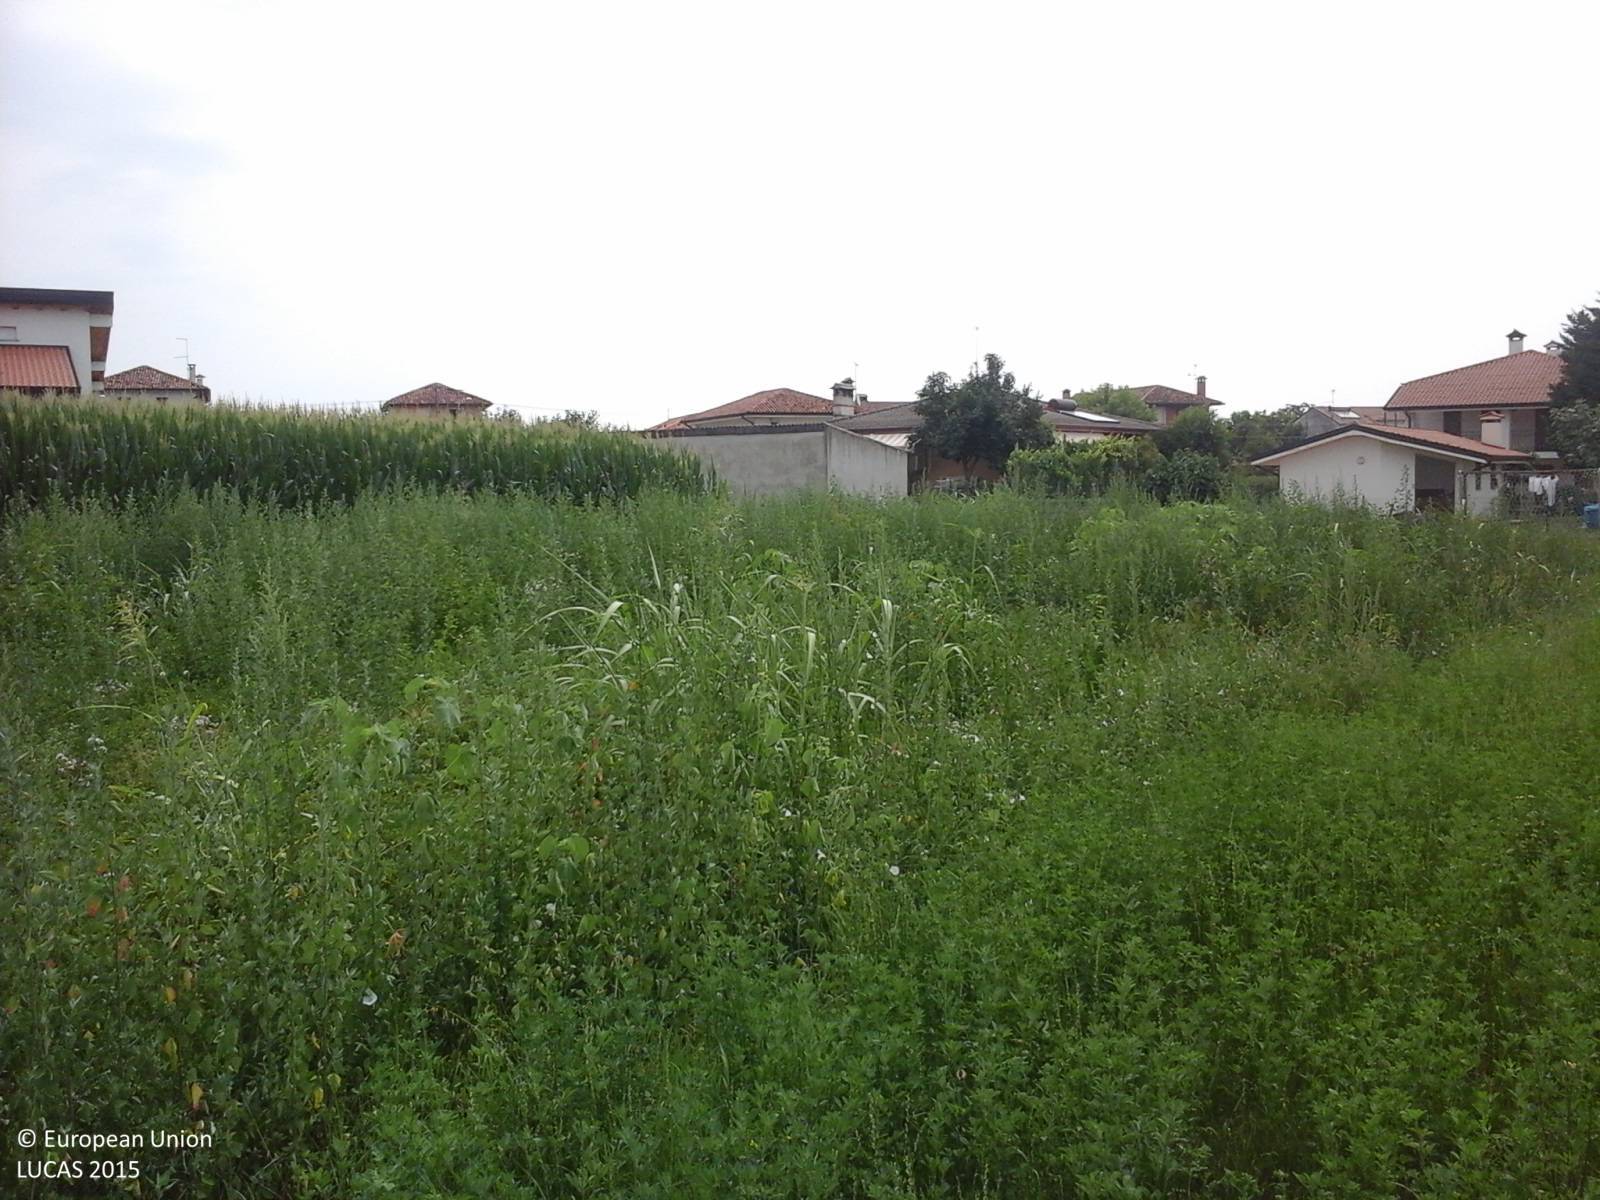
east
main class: Cropland
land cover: Lucerne
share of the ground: > 75 %
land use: Agriculture (excluding fallow land and kitchen gardens)
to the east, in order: Lucerne; Spontaneously vegetated surfaces; Maize; Ditches and canals; Grass margins; Artificial constructions in urban areas; Grassland without tree/shrub cover; Artificial constructions in urban areas; Soya
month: July
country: IT
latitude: 45.9471
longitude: 13.0537
